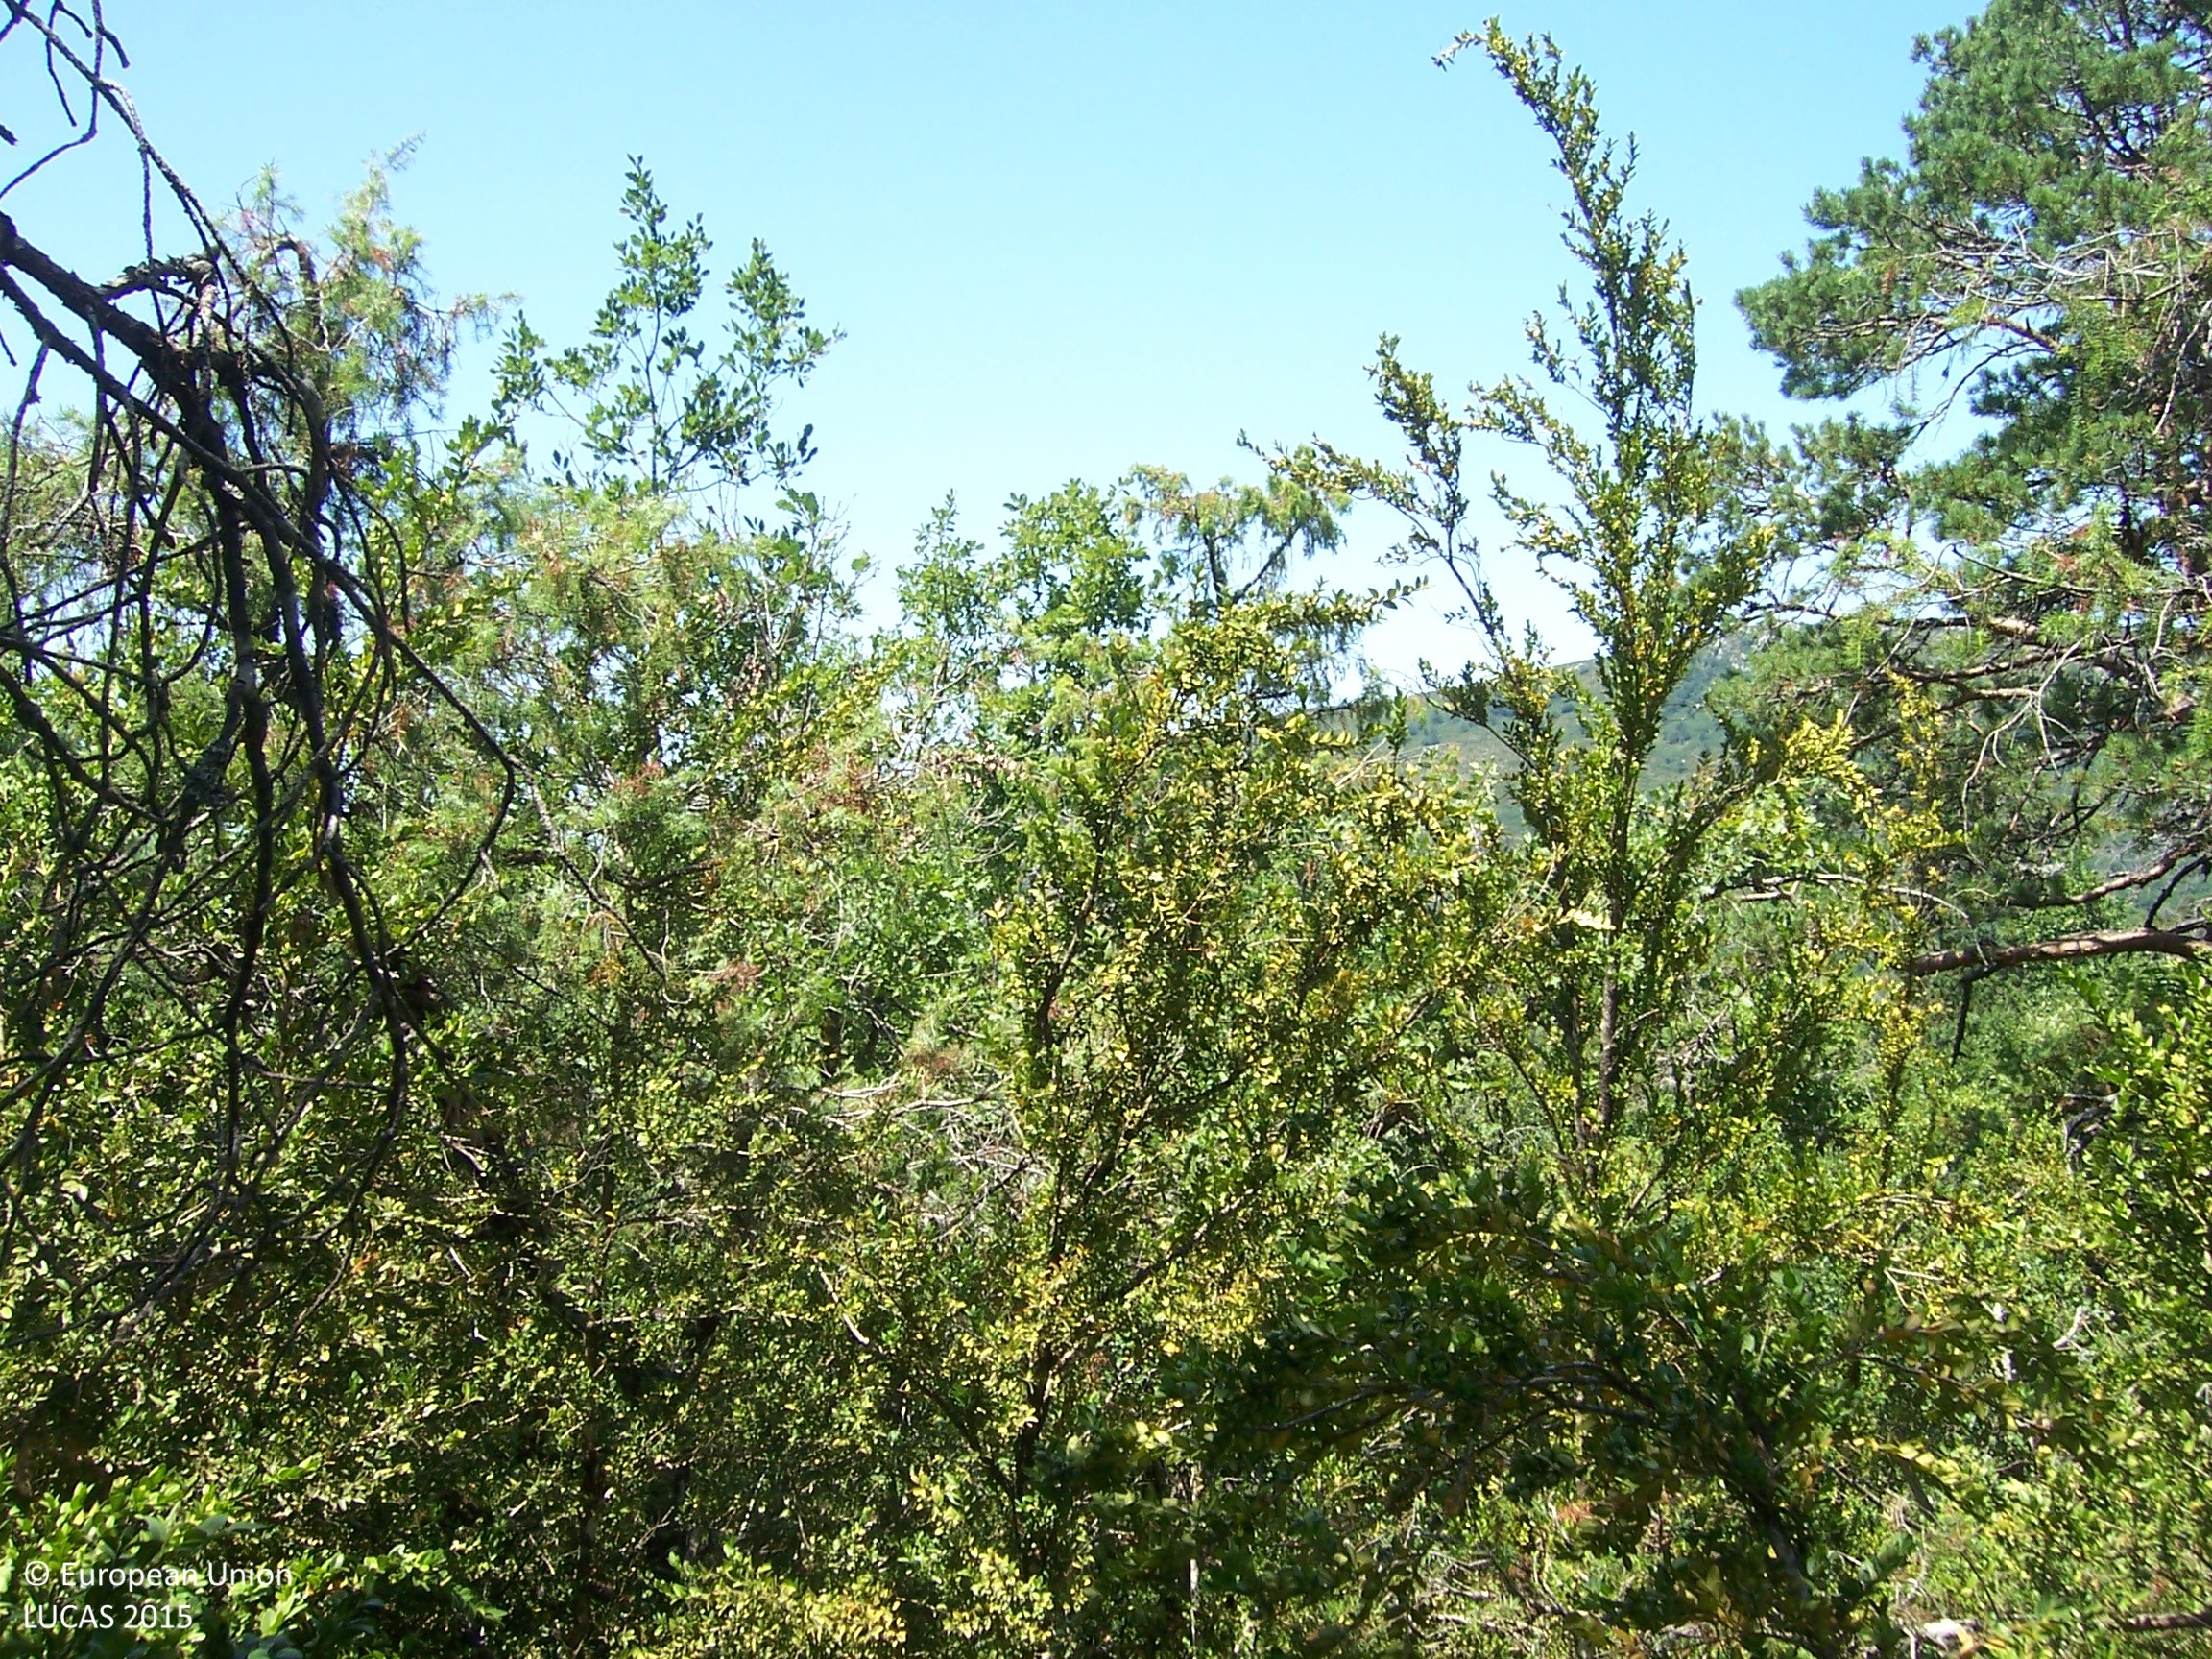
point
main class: Woodland
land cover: Pine dominated mixed woodland
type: coniferous forest of the mediterranean region
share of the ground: > 75 %
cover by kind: coniferous forest trees 75 %, broadleaved forest trees 25 %
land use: Forestry
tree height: > 5 m
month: July
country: ES
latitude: 42.8415
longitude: -1.2800
